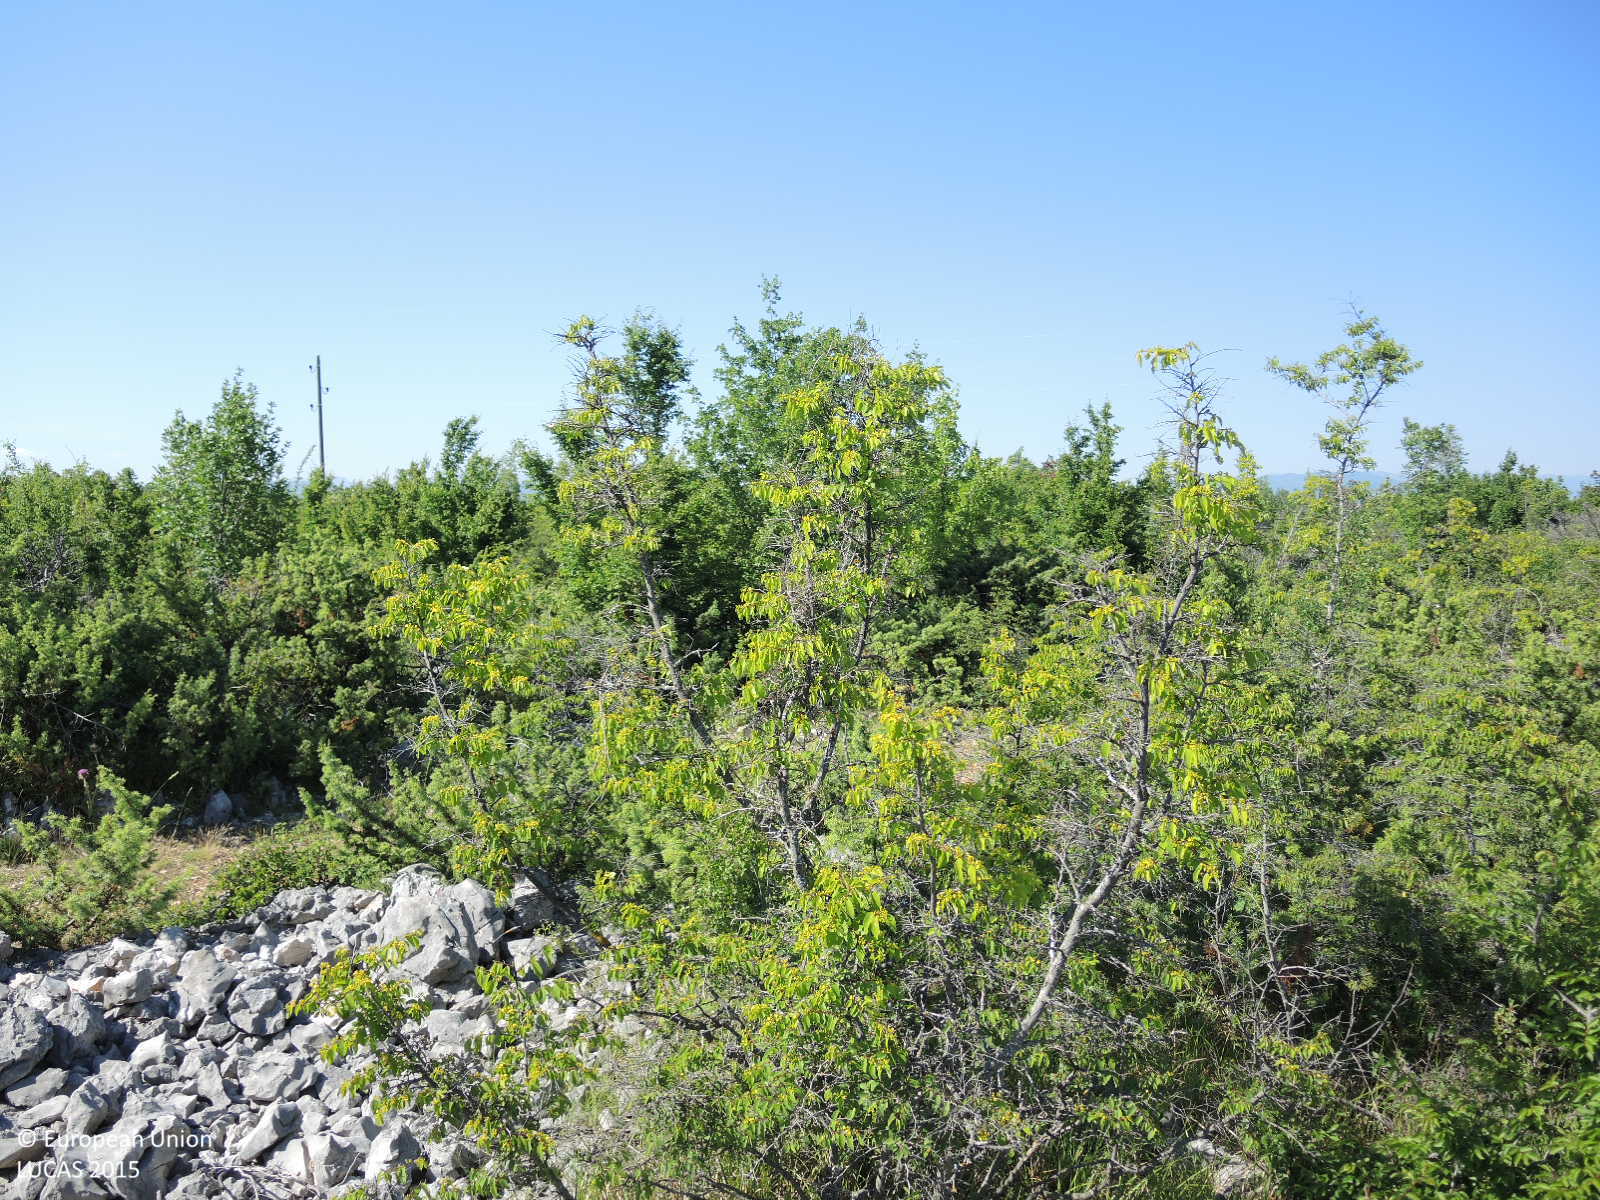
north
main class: Shrubland
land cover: Shrubland with sparse tree cover
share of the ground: 50 - 75 %
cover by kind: shrubs 50 %, unconsolidated bare surface 30 %, herbaceous plants 10 %, broadleaved forest trees 5 %, consolidated bare surface 5 %
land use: Semi-natural and natural areas not in use
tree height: < 5 m
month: May
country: HR
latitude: 43.9290
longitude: 15.9084
